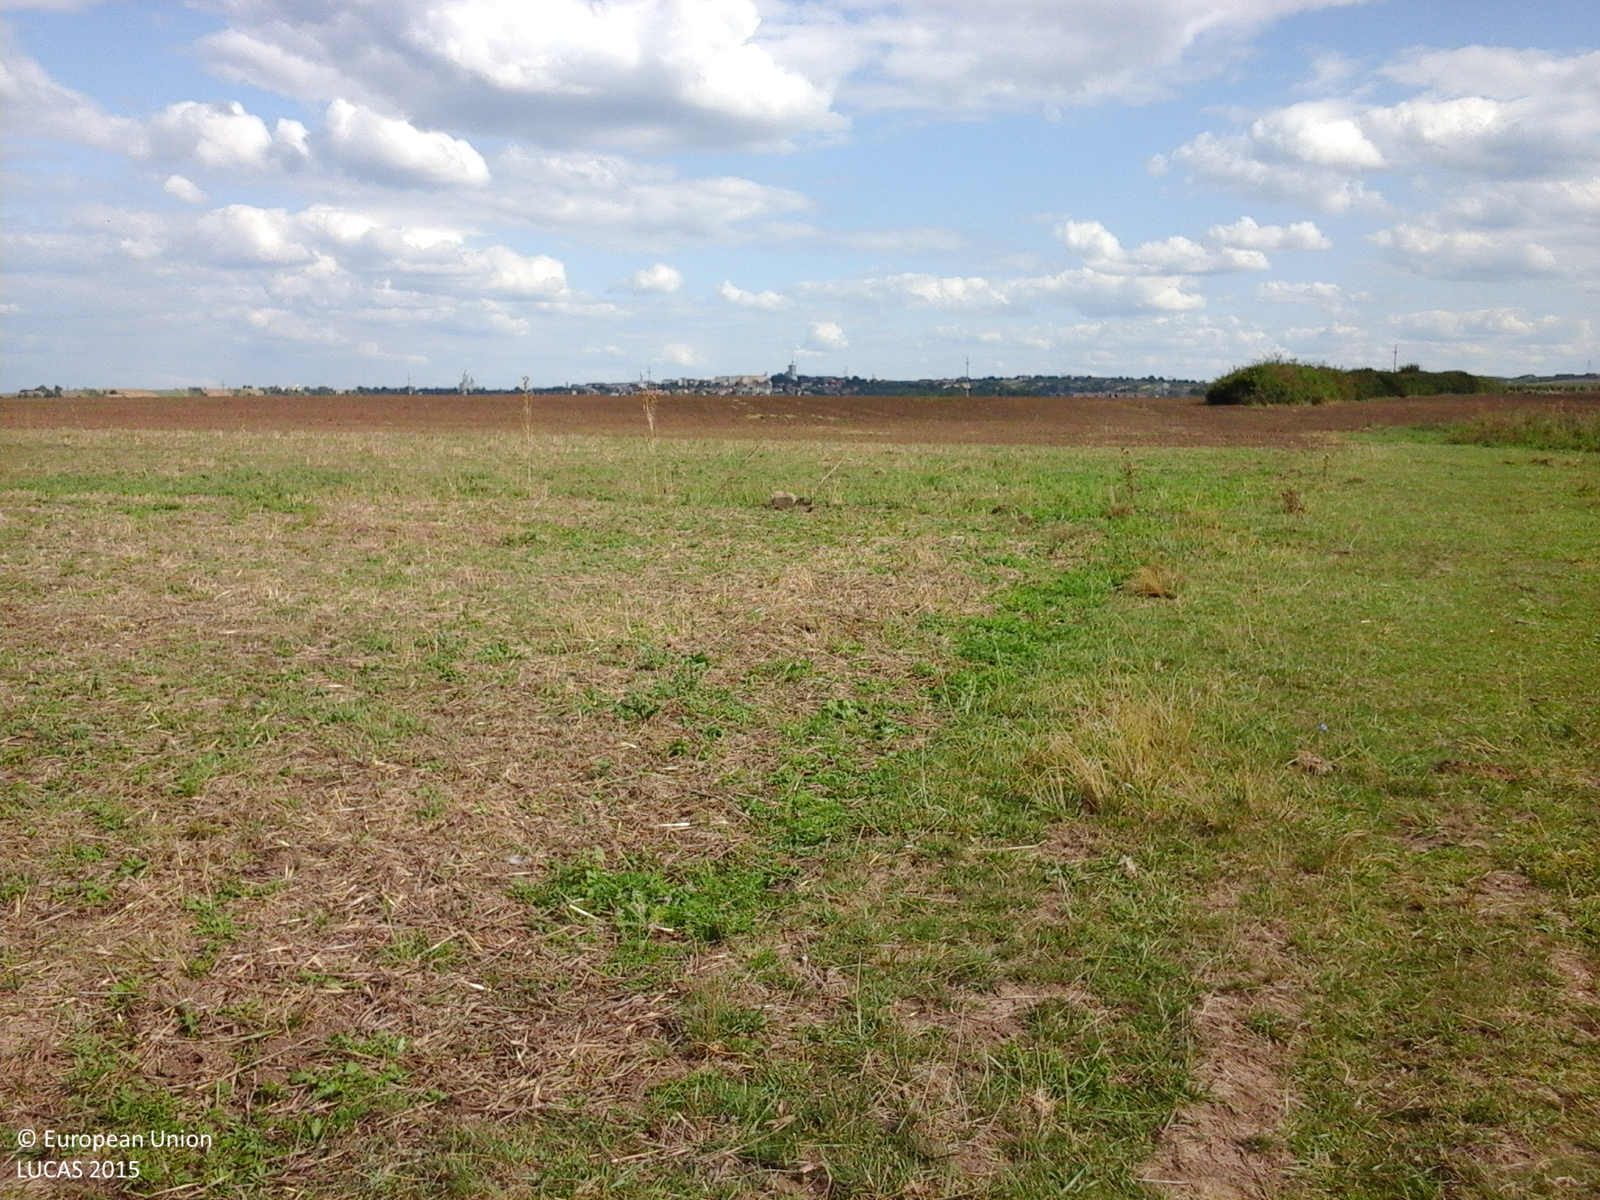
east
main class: Grassland
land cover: Grassland without tree/shrub cover
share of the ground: > 75 %
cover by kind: herbaceous plants 100 %
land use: Agriculture (excluding fallow land and kitchen gardens)
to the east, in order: Grassland without tree/shrub cover; Common wheat; Other bare soil
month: September
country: RO
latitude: 47.4852
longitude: 22.5461
